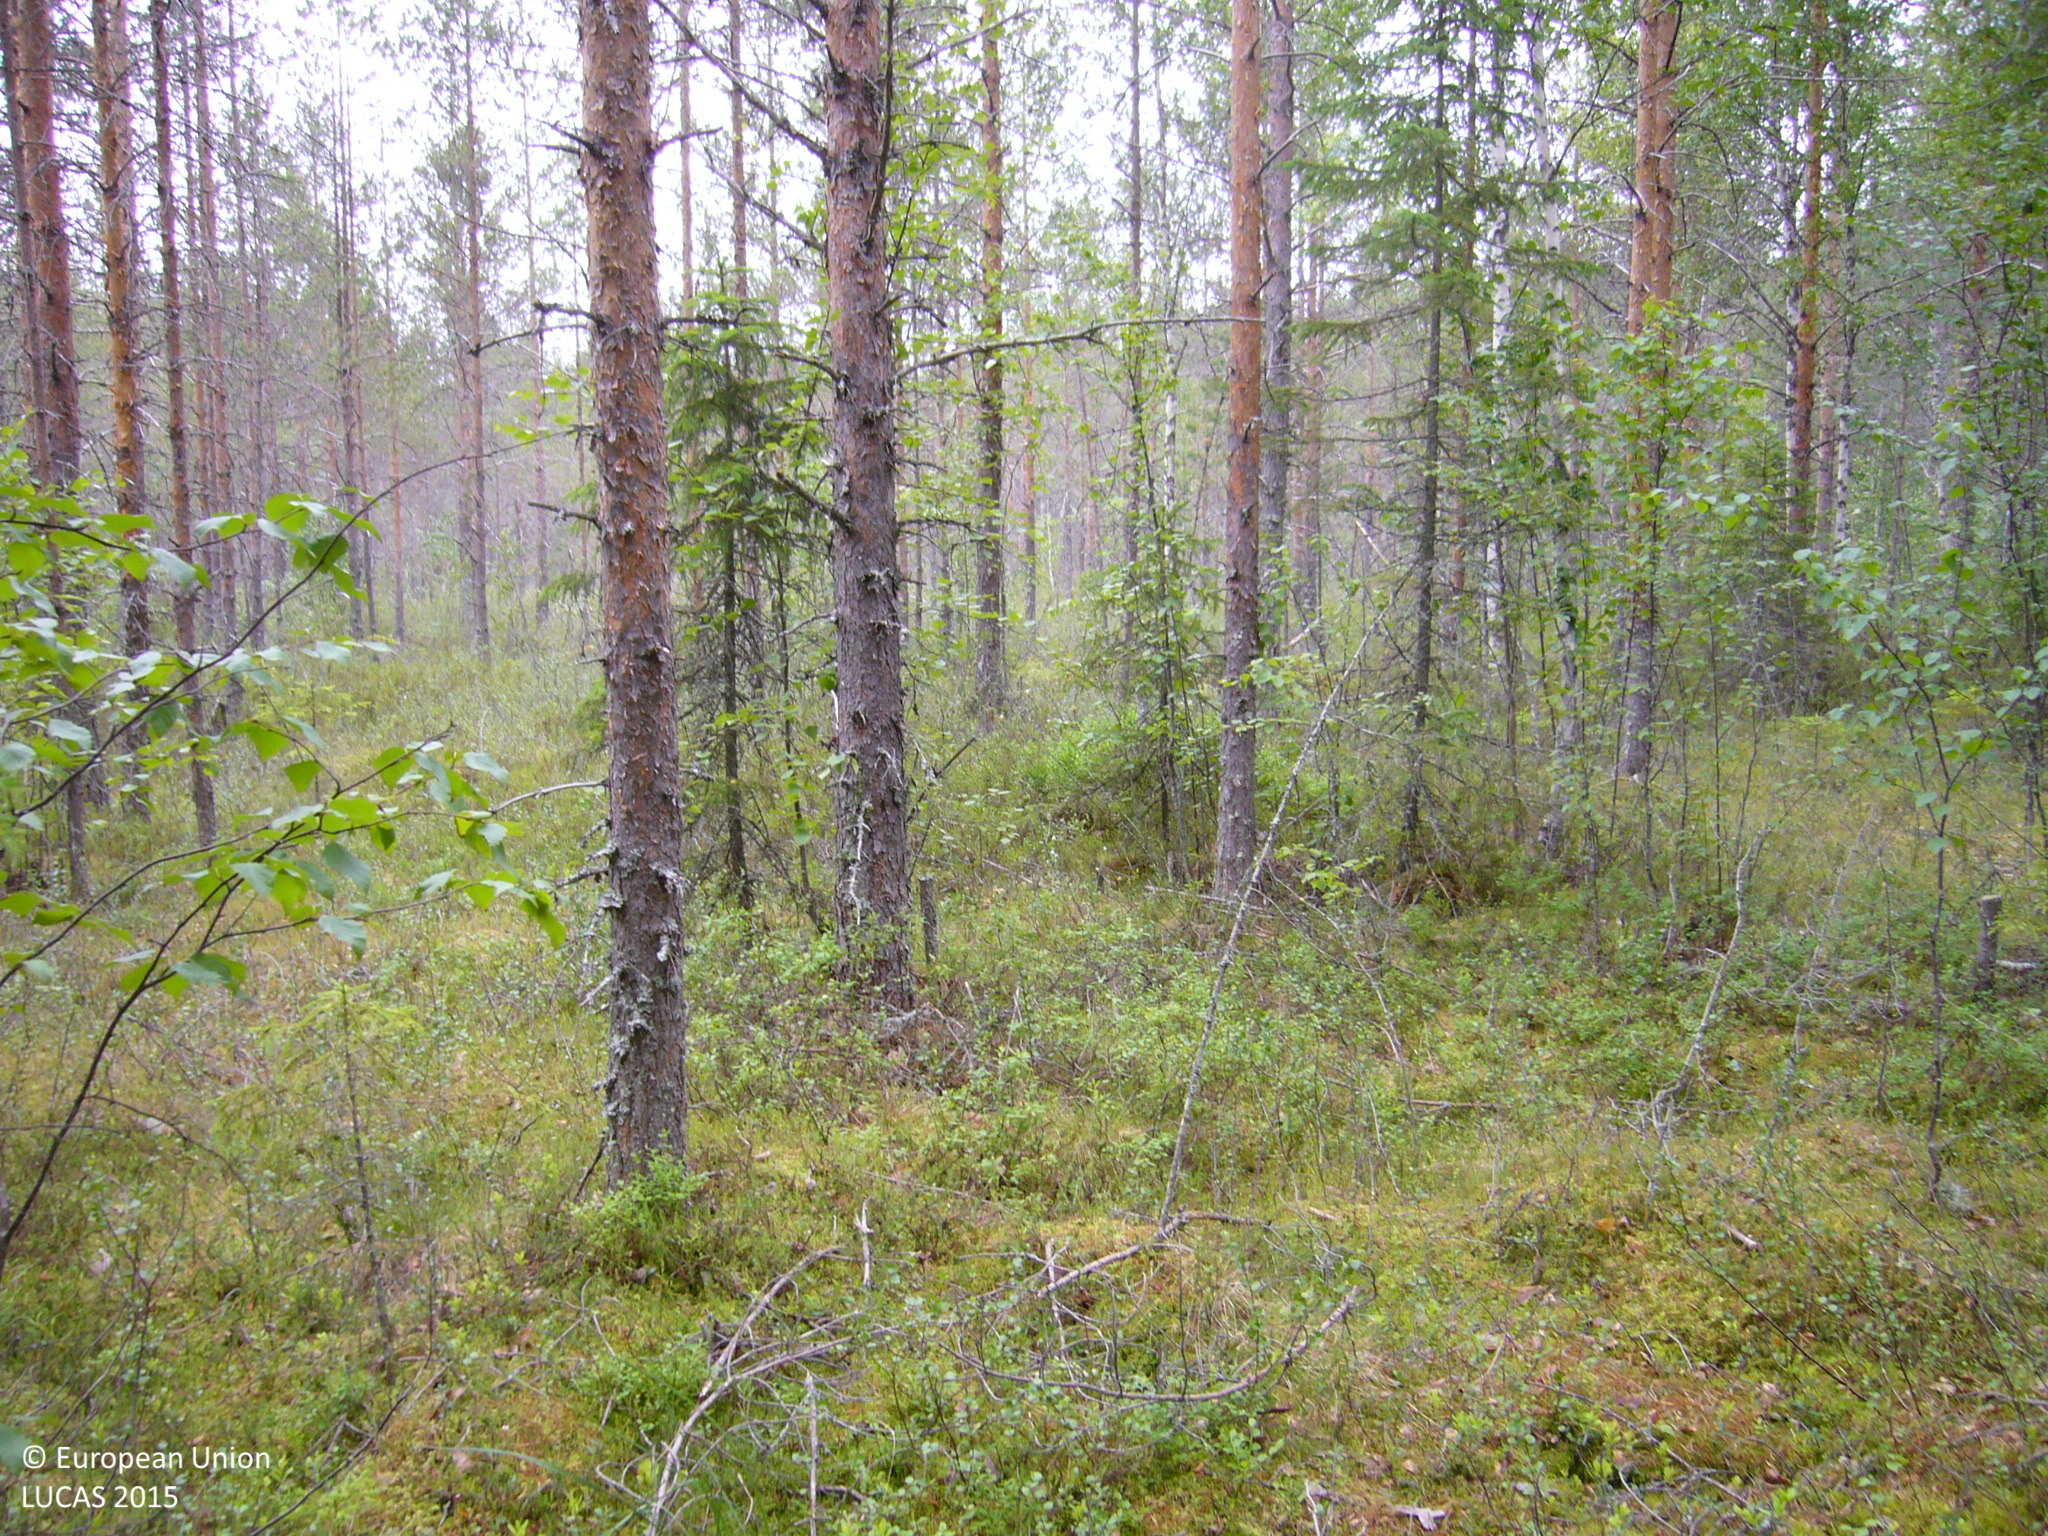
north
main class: Woodland
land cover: Pine dominated mixed woodland
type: boreal forest
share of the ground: > 75 %
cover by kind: coniferous forest trees 50 %, broadleaved forest trees 30 %, shrubs 20 %
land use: Forestry
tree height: > 5 m
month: July
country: FI
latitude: 63.5037
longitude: 26.0052
